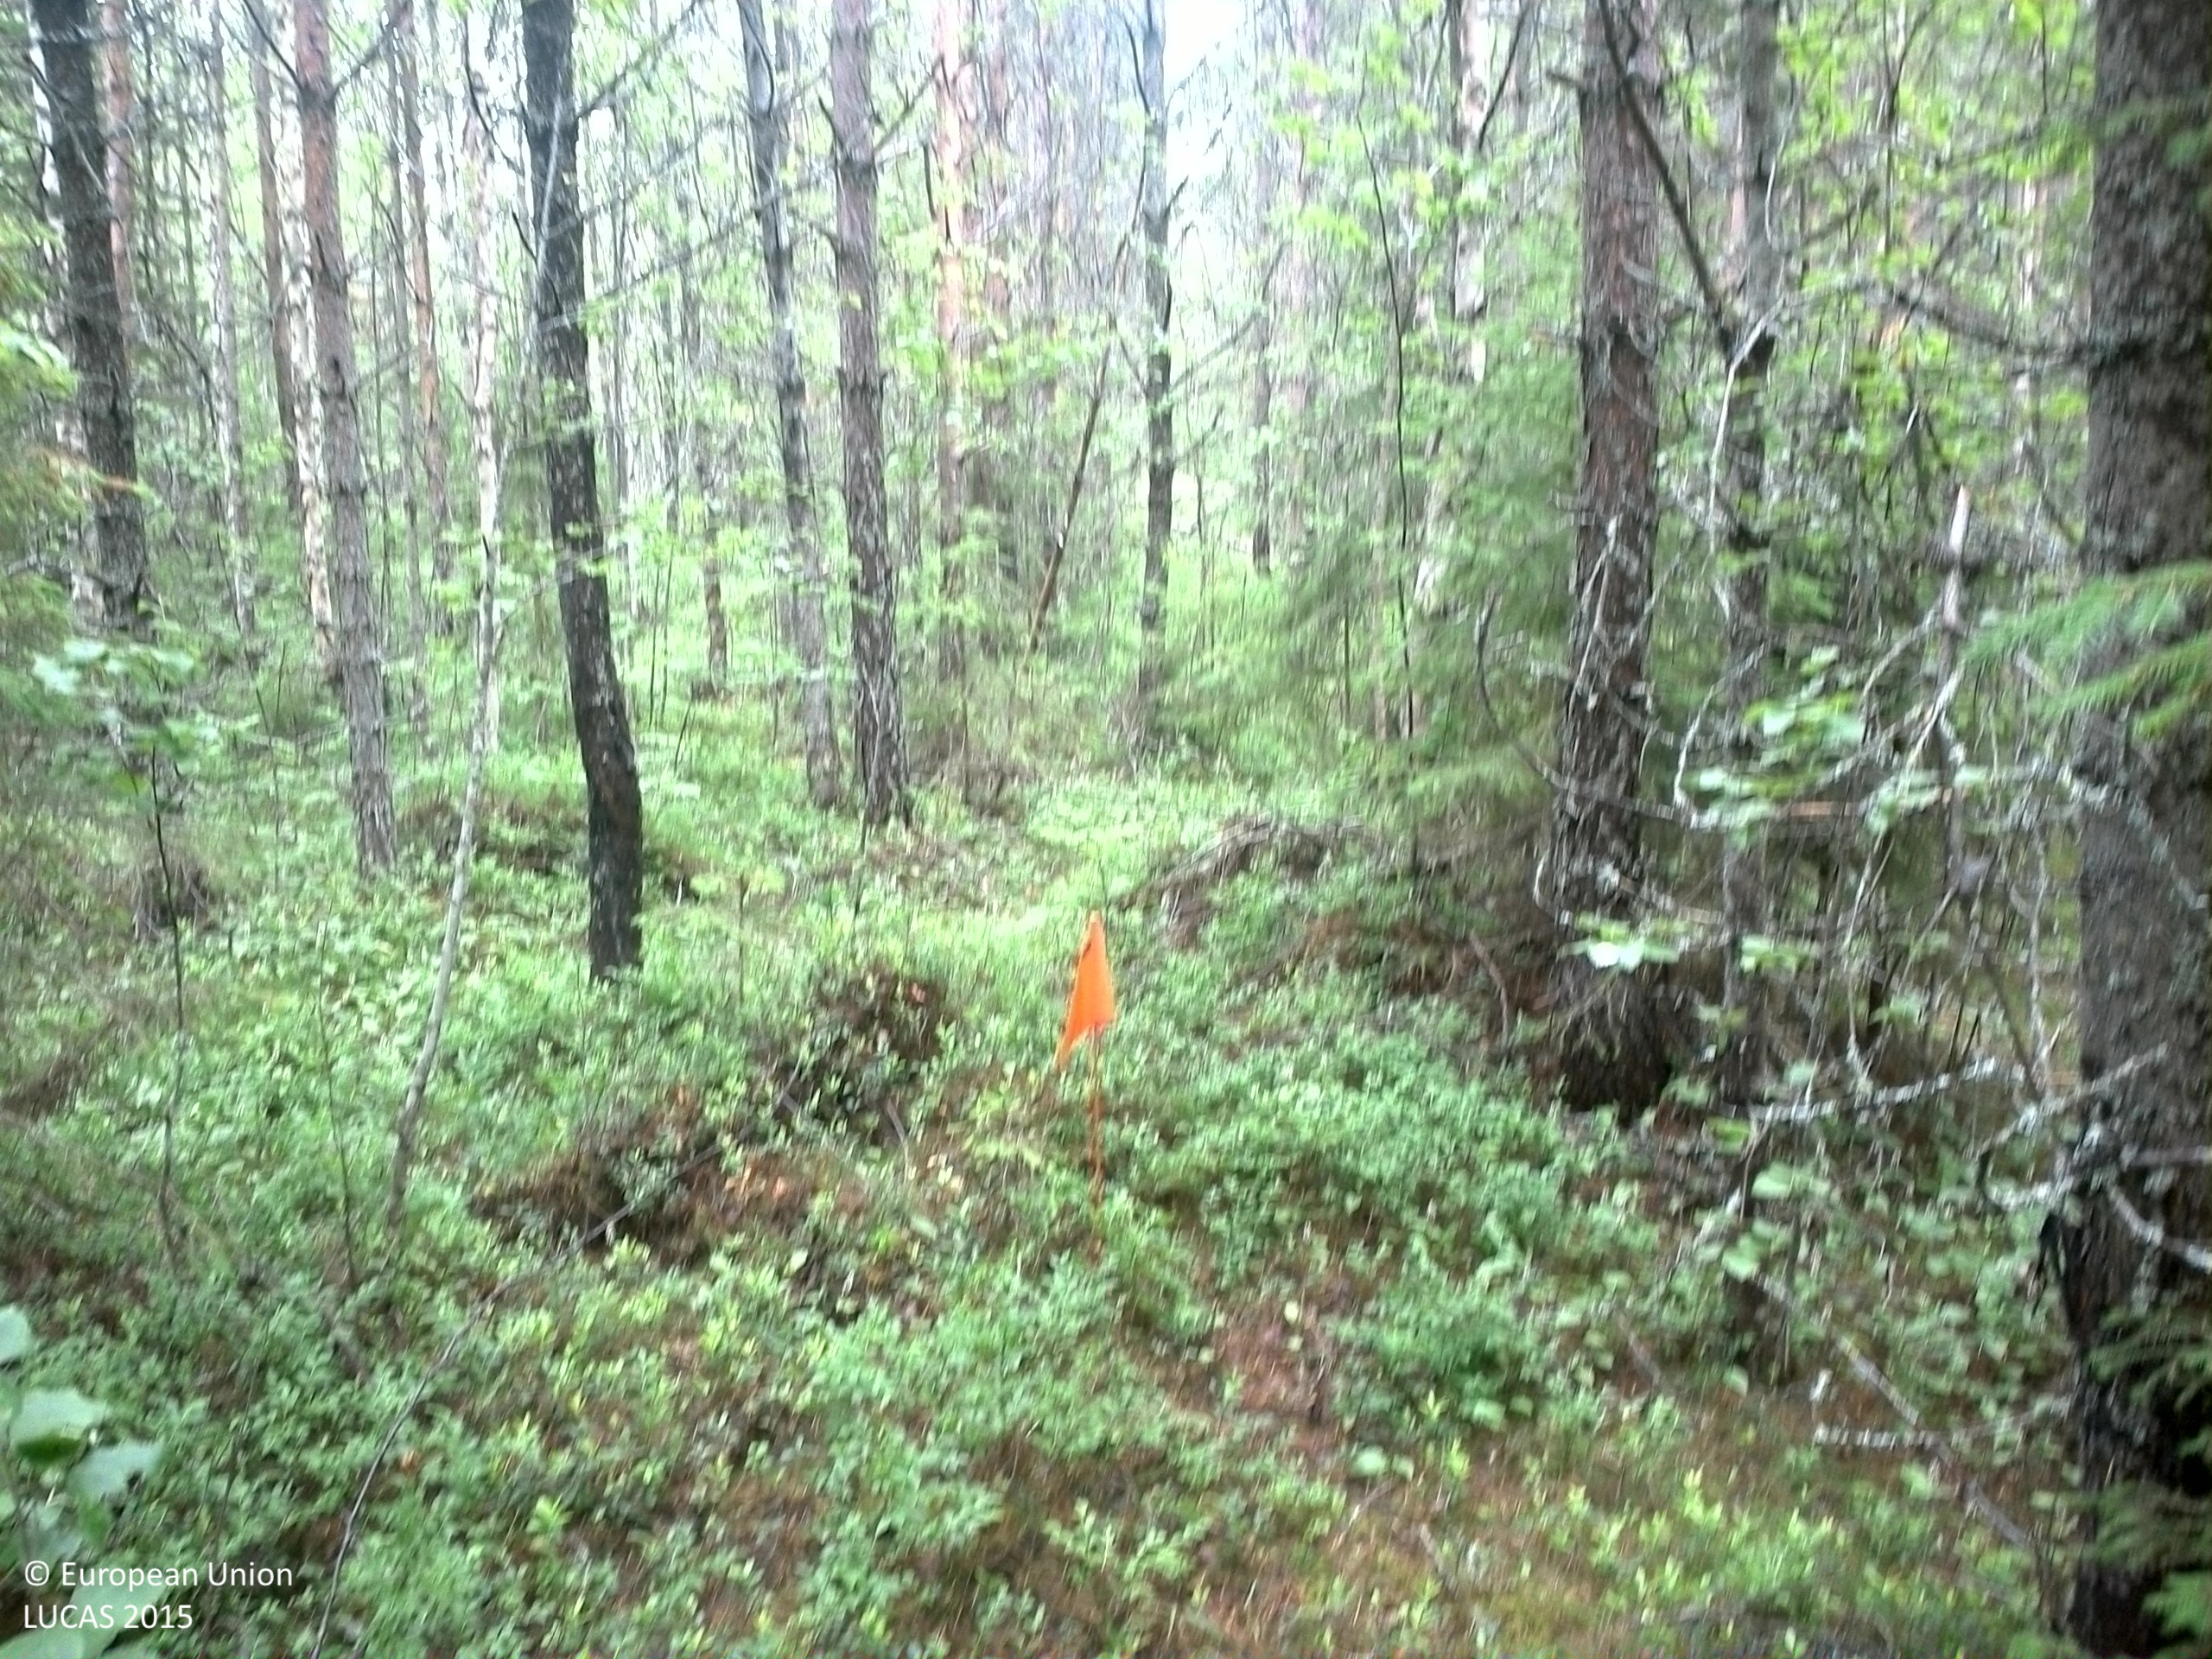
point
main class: Woodland
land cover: Pine dominated mixed woodland
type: exotic forest
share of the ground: > 75 %
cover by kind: coniferous forest trees 60 %, broadleaved forest trees 20 %, shrubs 20 %
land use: Forestry
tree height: > 5 m
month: July
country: SE
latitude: 63.5686
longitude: 18.5334
